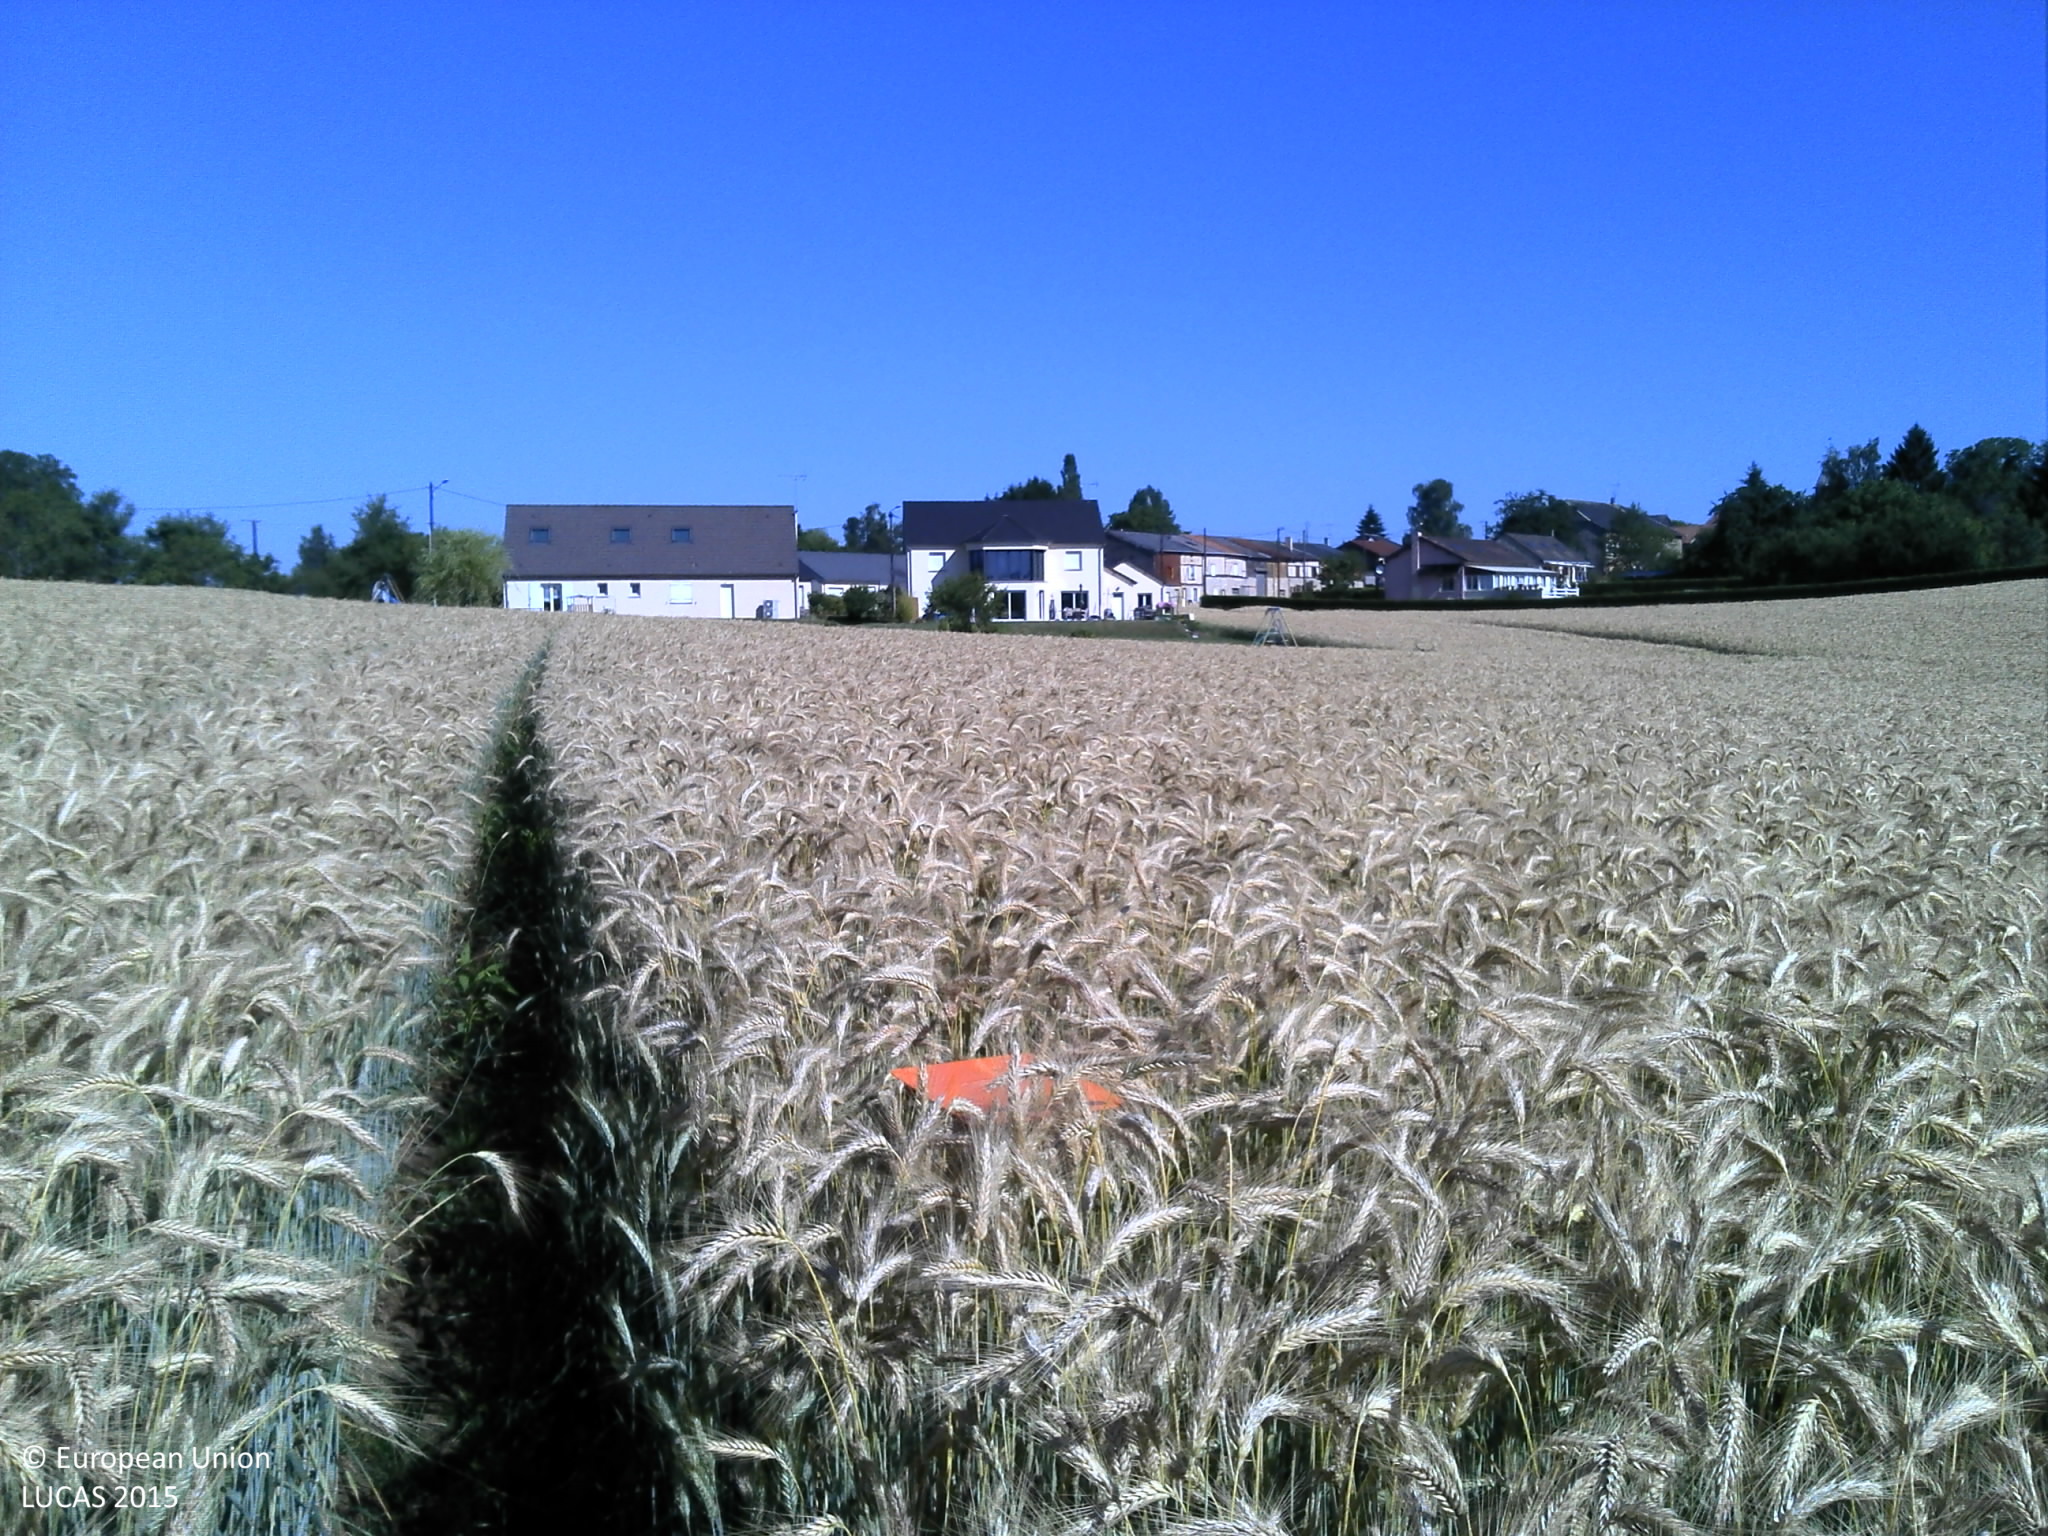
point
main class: Cropland
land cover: Triticale
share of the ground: > 75 %
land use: Agriculture (excluding fallow land and kitchen gardens)
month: July
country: FR
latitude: 49.5911
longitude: 4.6707
